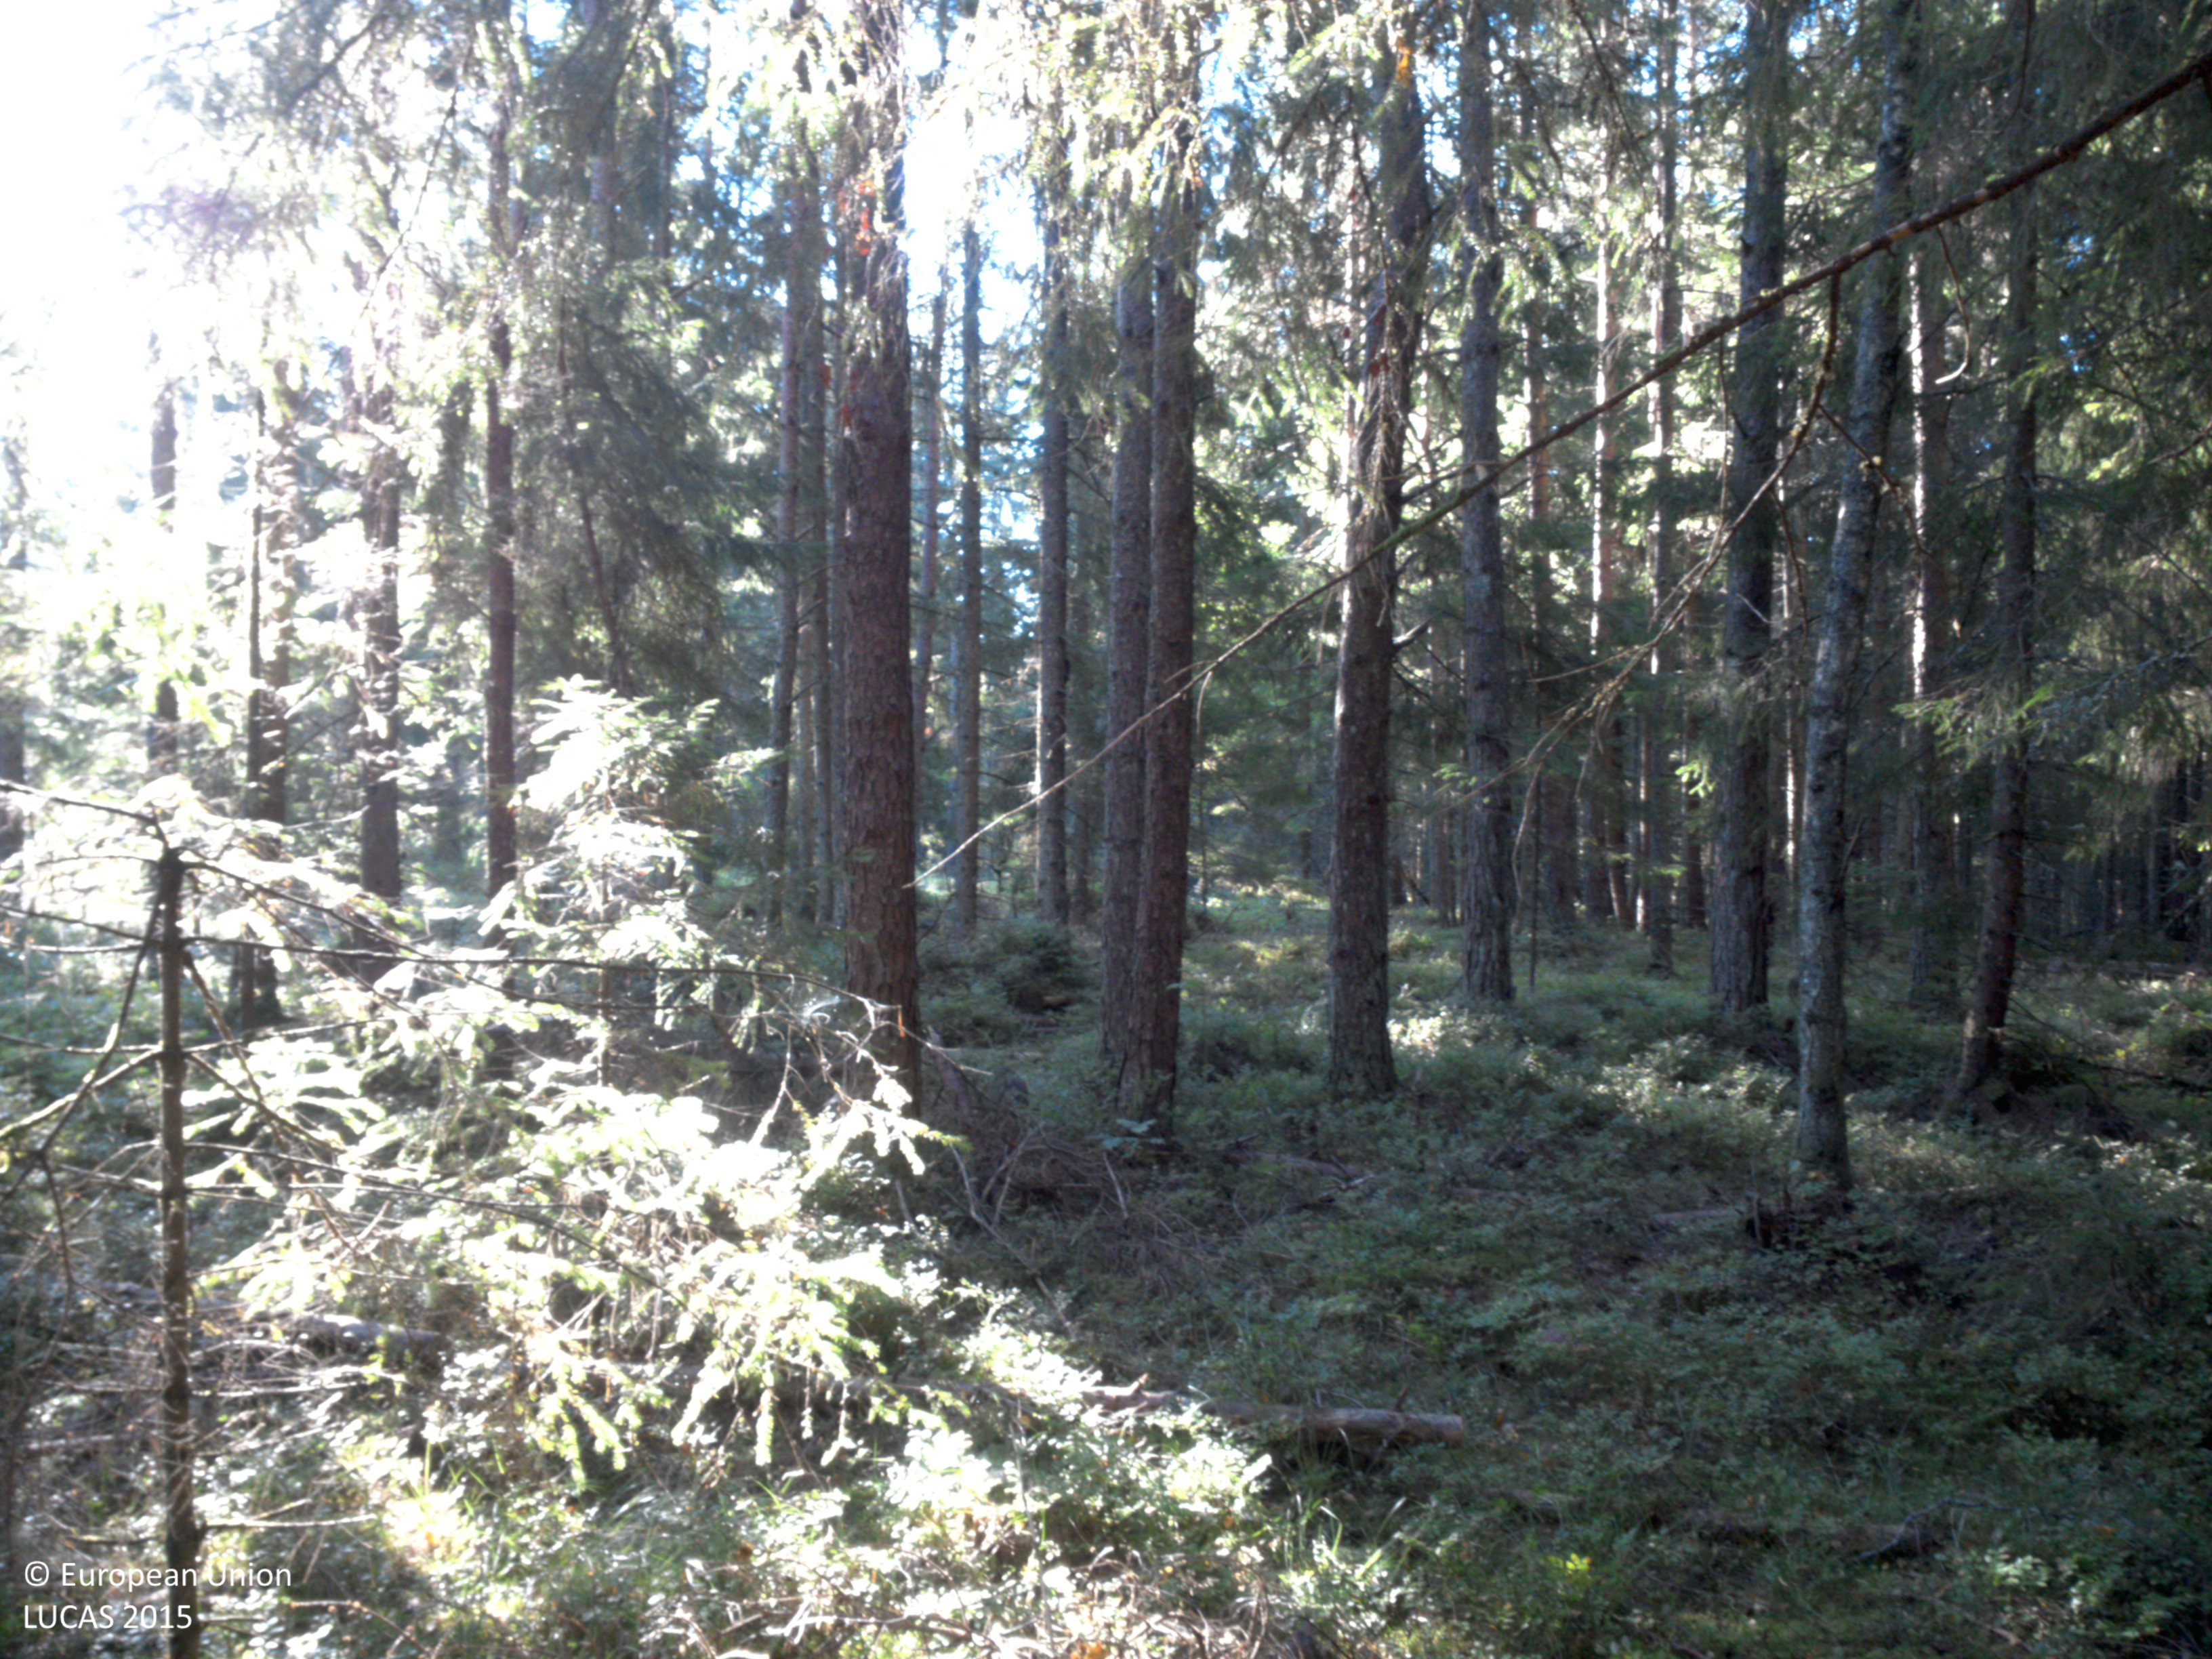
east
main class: Woodland
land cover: Spruce dominated coniferous woodland
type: boreal forest
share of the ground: 50 - 75 %
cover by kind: coniferous forest trees 60 %, shrubs 15 %, lichens and mosses 15 %, herbaceous plants 10 %
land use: Forestry
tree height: > 5 m
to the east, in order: Spruce dominated coniferous woodland; Pine dominated coniferous woodland; Spruce dominated coniferous woodland; Ditches and canals; Grass margins; Oats
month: August
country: SE
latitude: 58.5426
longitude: 12.2460
